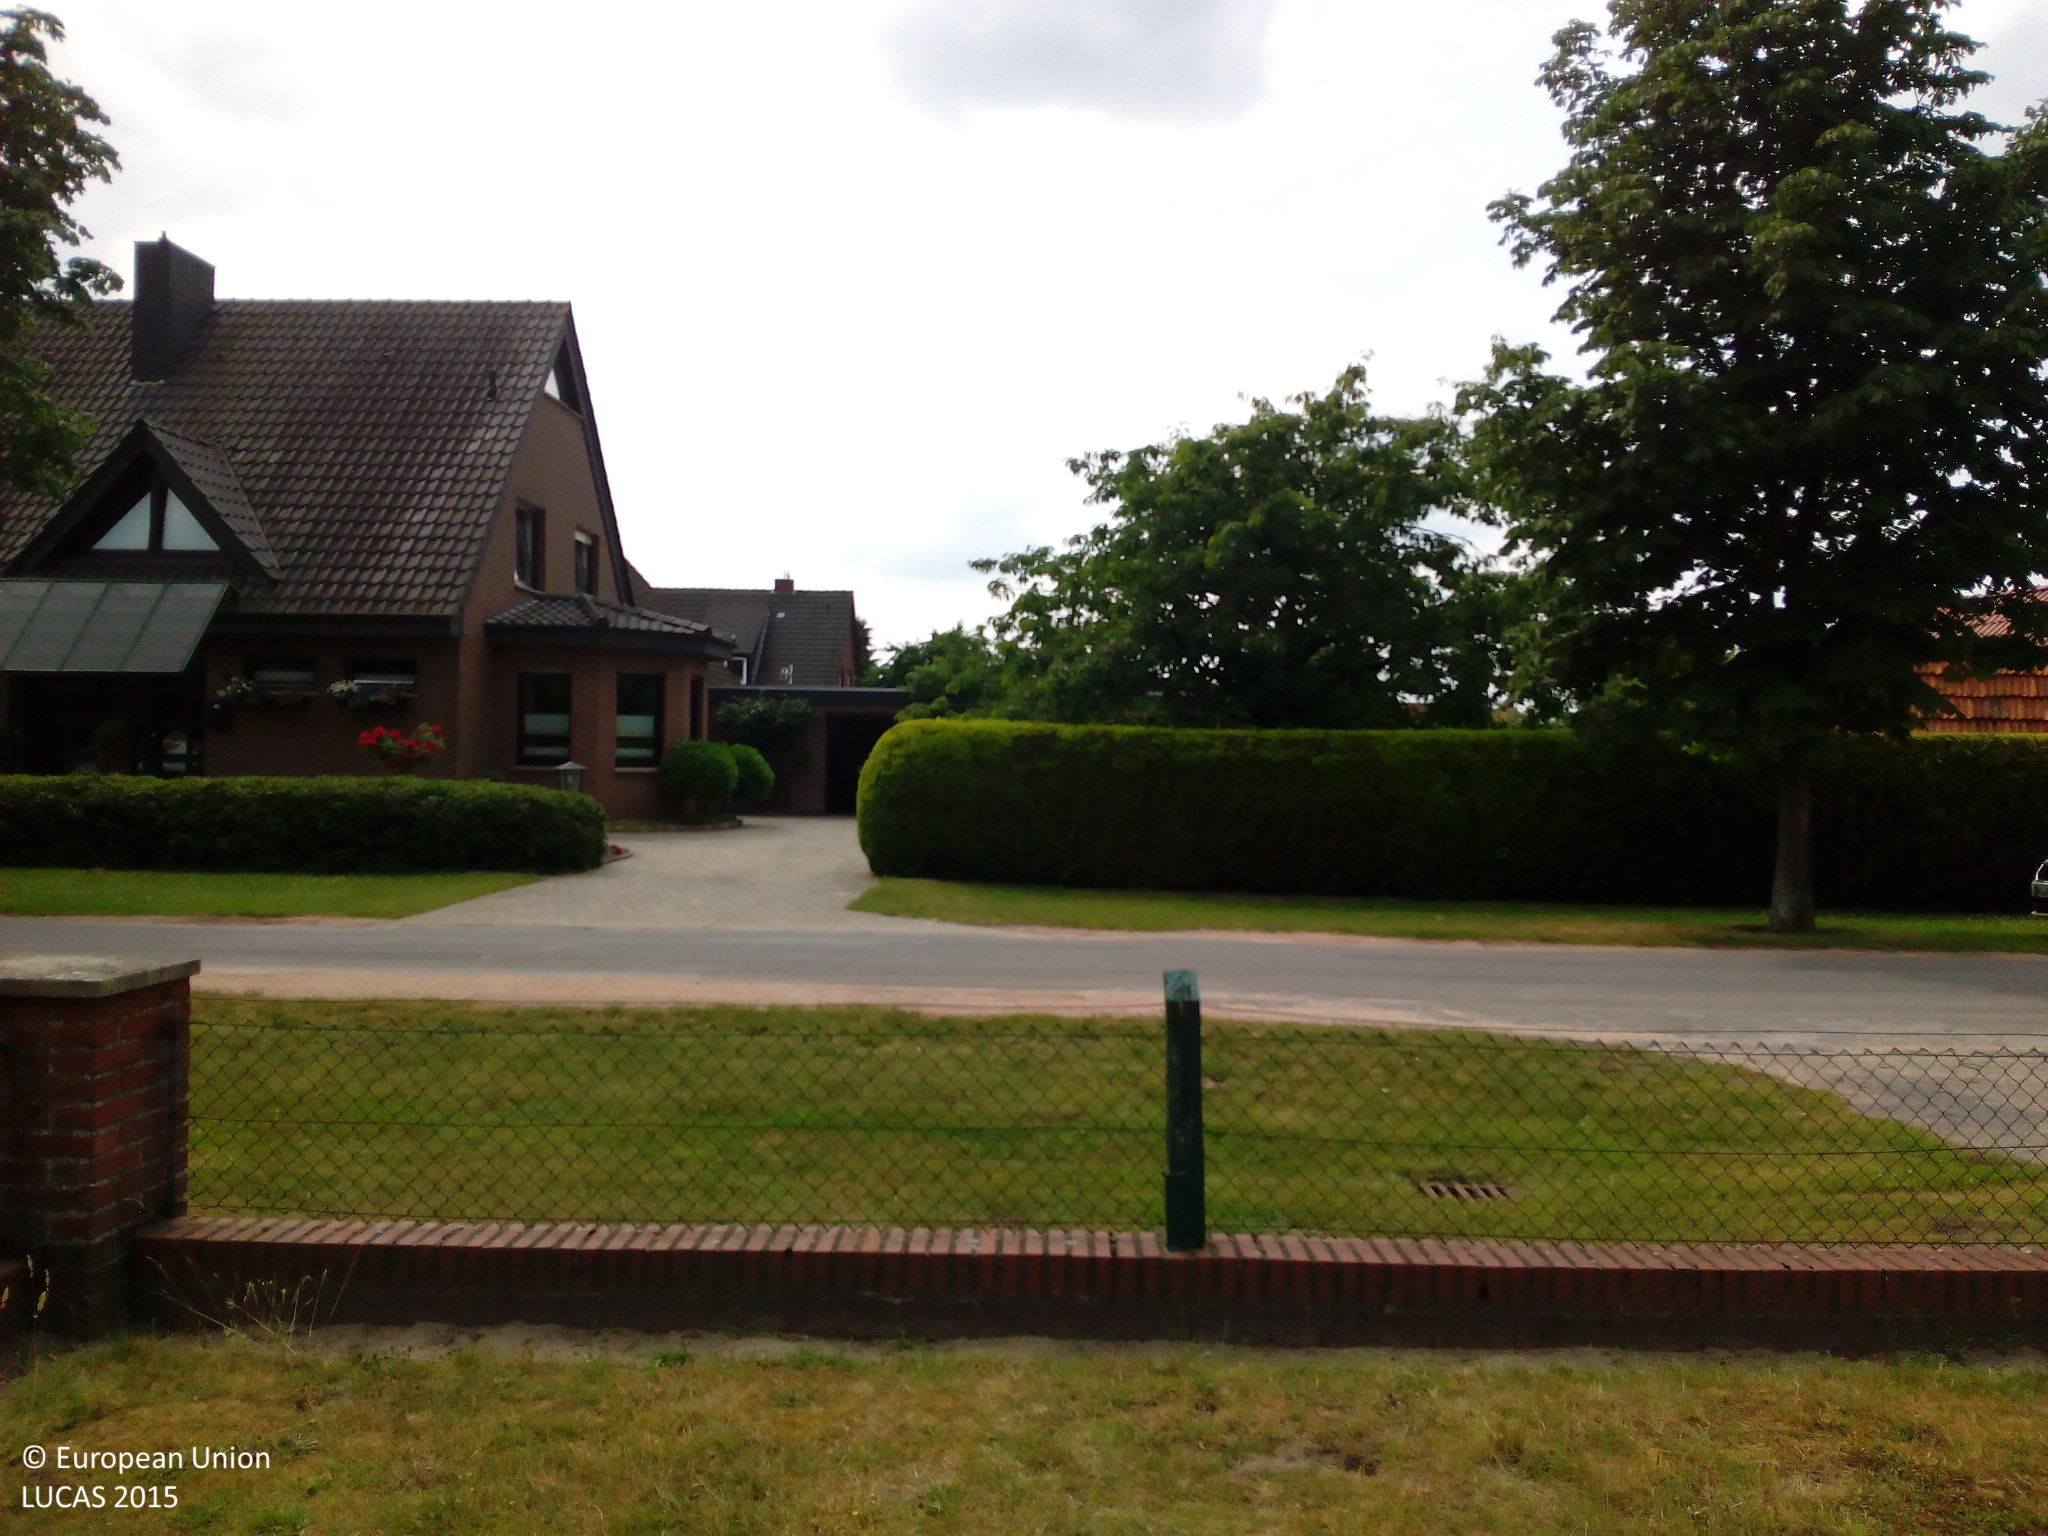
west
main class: Grassland
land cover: Grassland without tree/shrub cover
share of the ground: > 75 %
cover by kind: herbaceous plants 100 %
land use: Residential
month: July
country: DE
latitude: 52.6717
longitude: 7.3532
